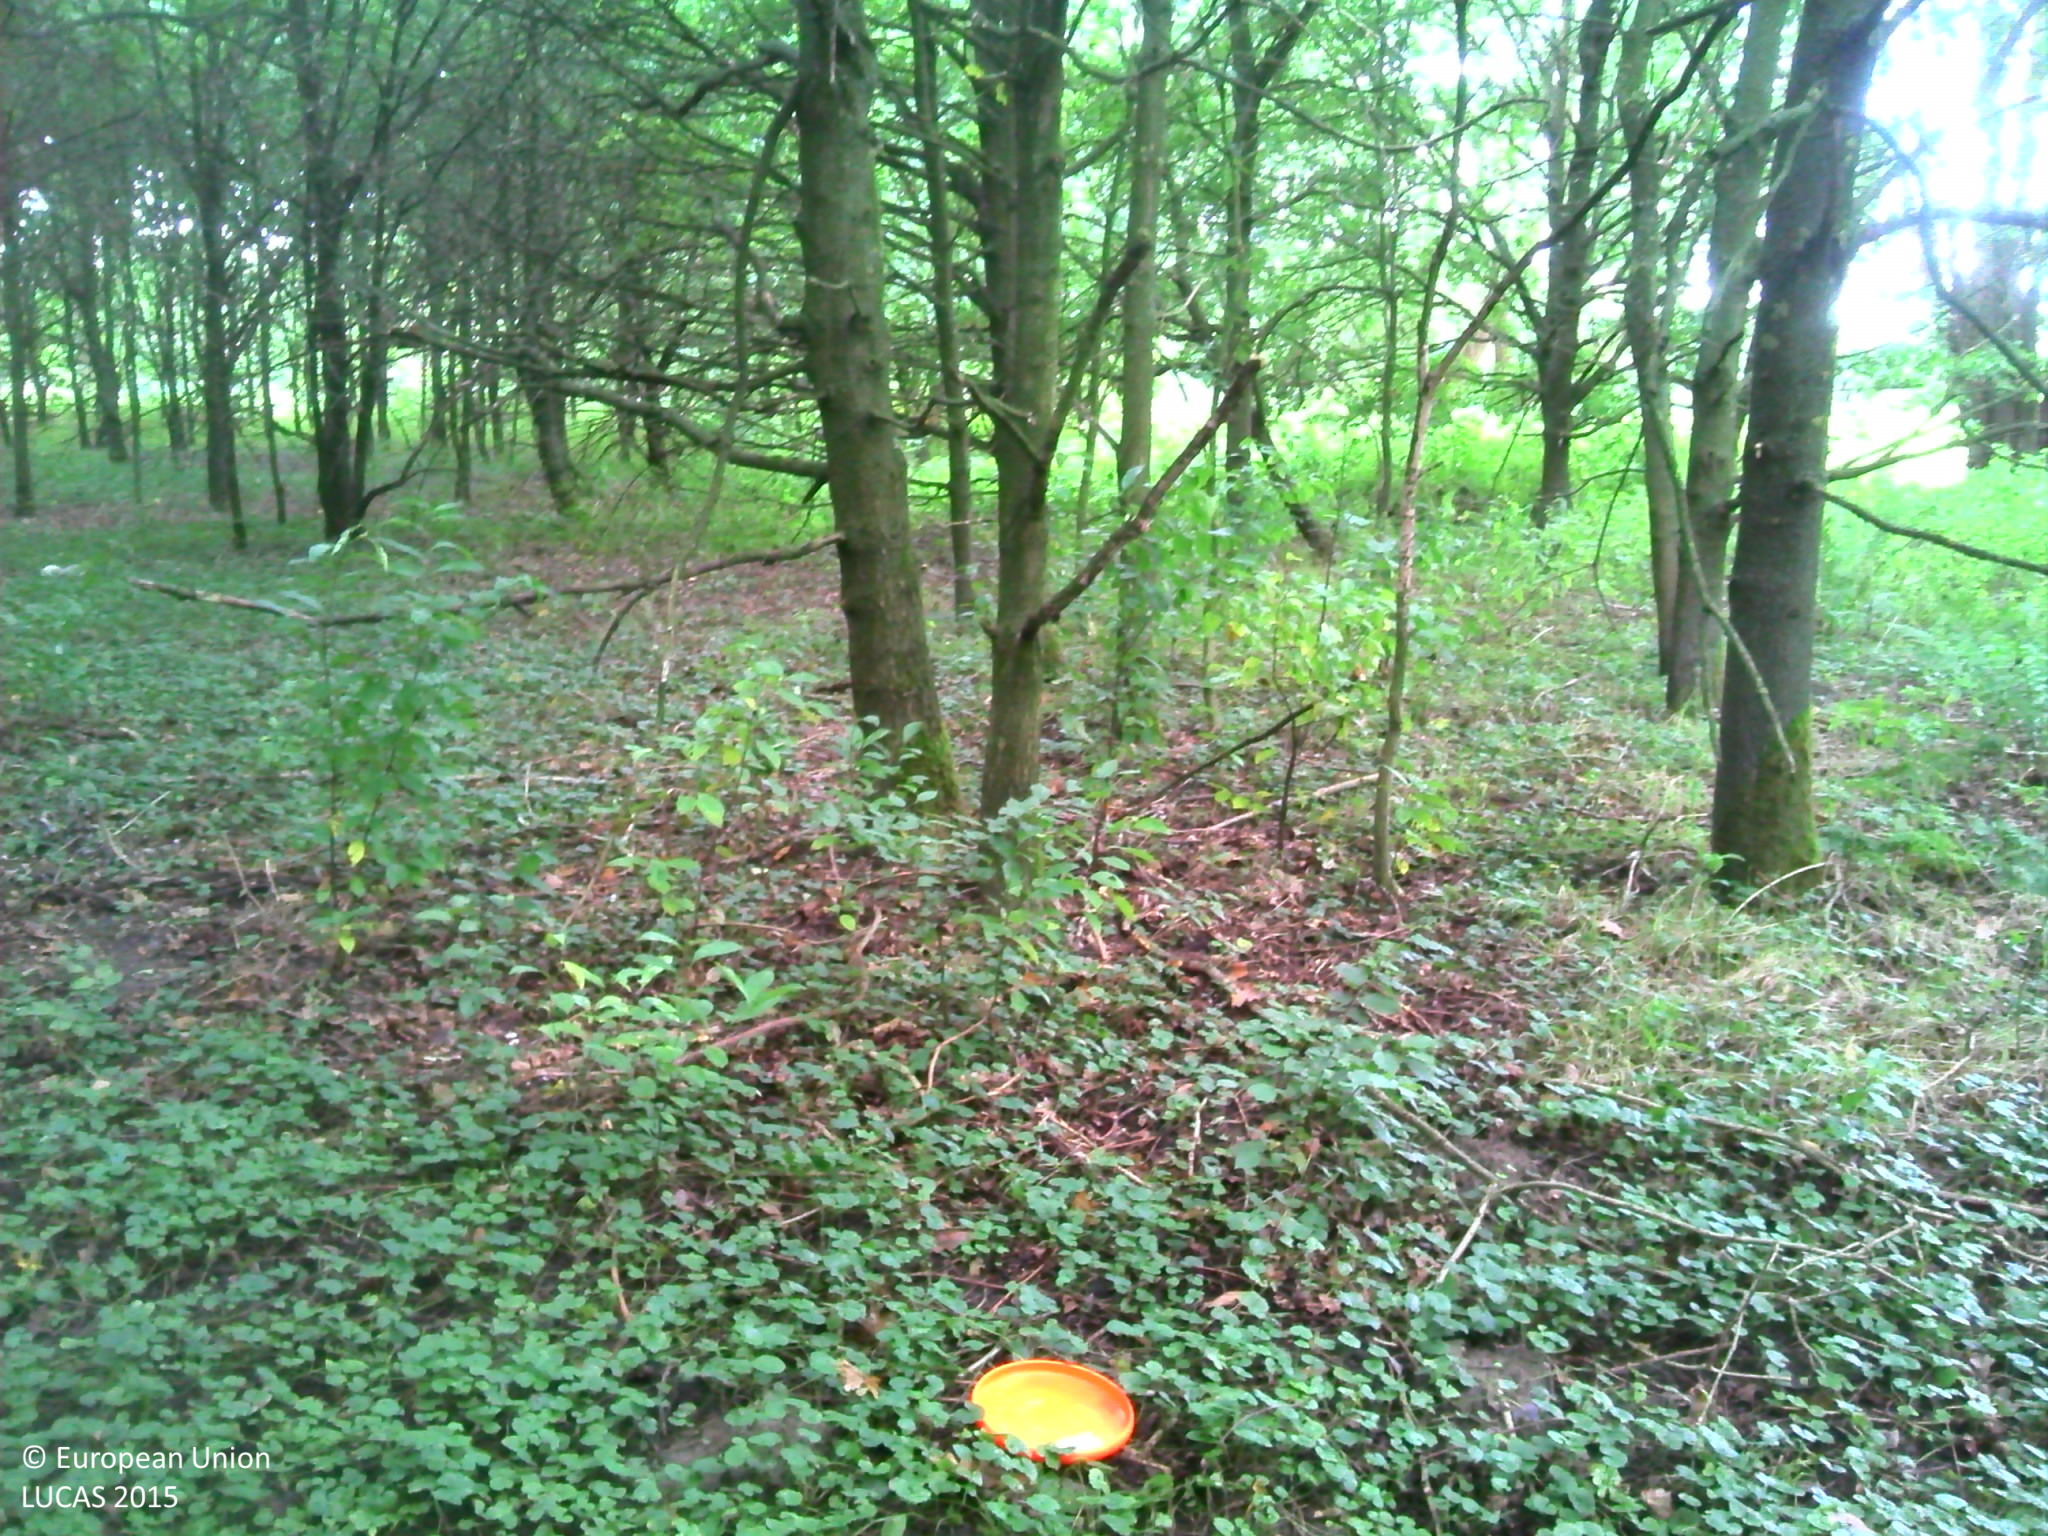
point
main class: Woodland
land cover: Broadleaved woodland
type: mesophytic deciduous forest
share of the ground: > 75 %
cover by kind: broadleaved forest trees 75 %, herbaceous plants 25 %
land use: Forestry
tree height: > 5 m
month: September
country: BE
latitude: 51.0330
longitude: 4.6773
